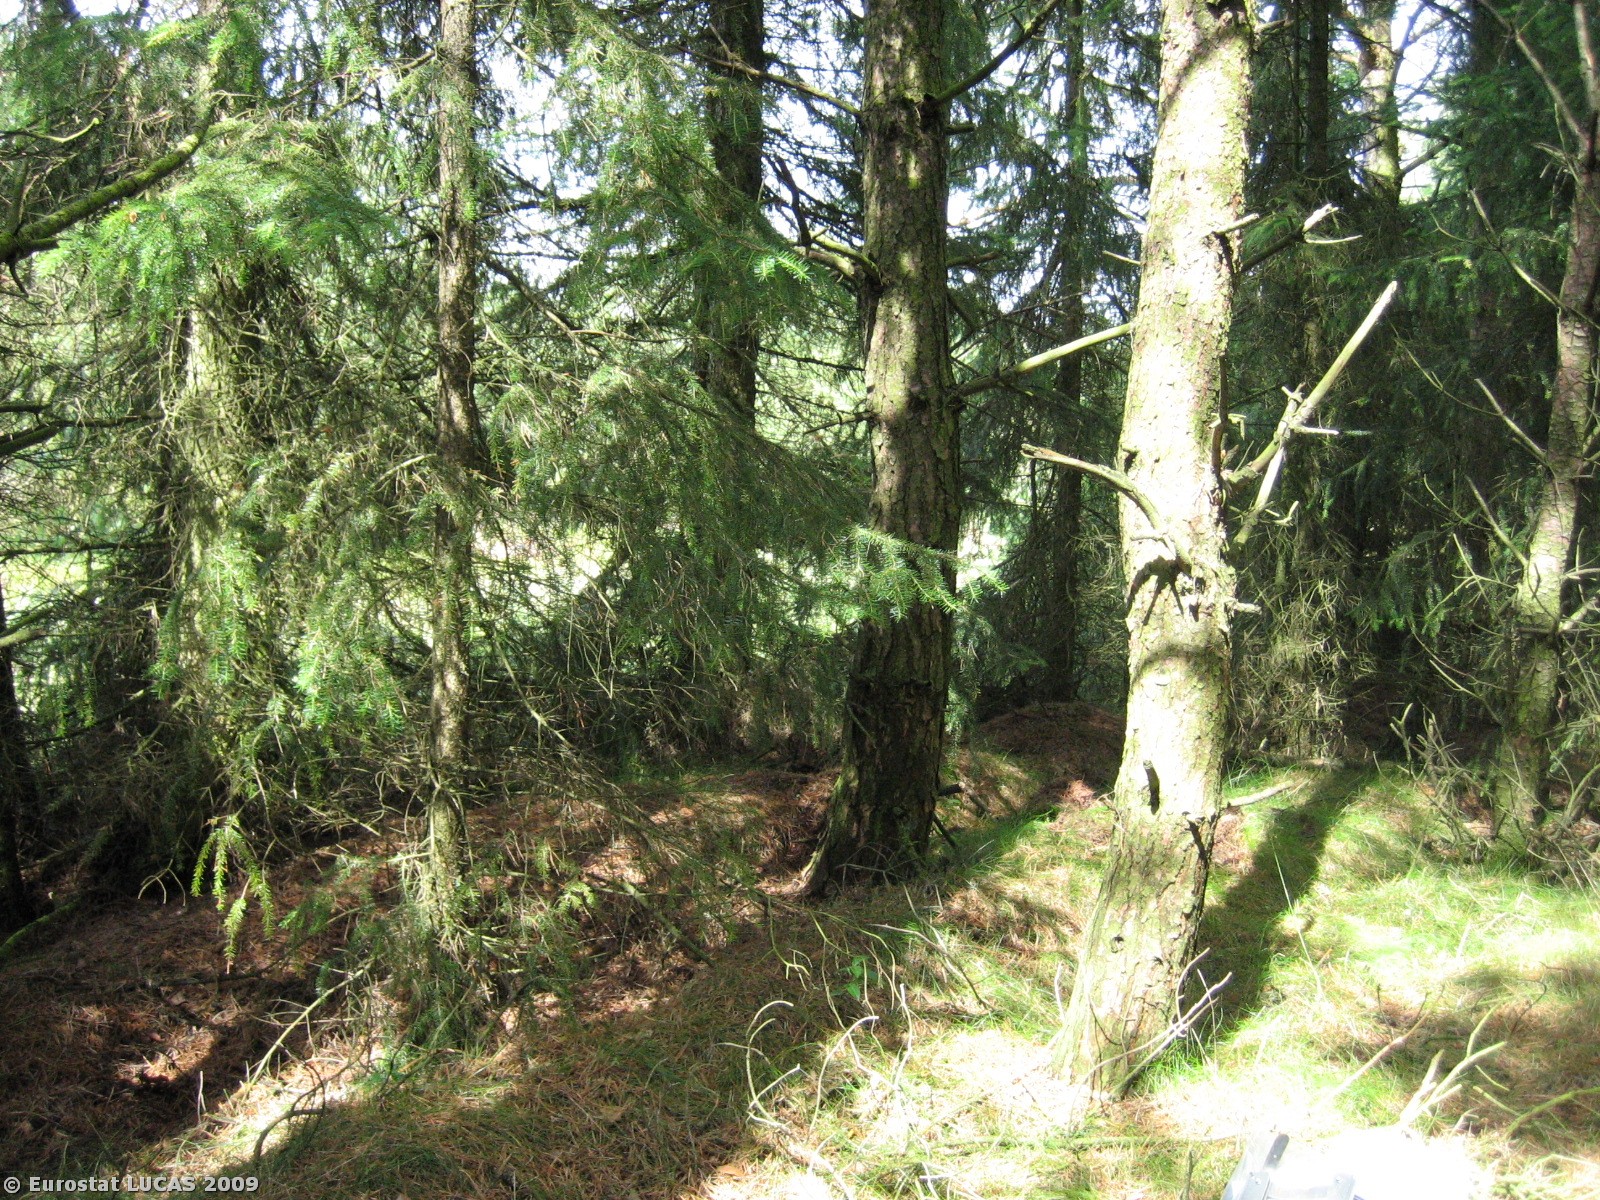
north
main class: Woodland
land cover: Coniferous woodland
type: hemiboreal forest and nemoral coniferous forest and mixed broadleaved-coniferous forest
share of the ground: > 75 %
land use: Forestry
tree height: > 5 m
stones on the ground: < 10 %
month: July
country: DK
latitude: 55.6786
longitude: 8.7767
